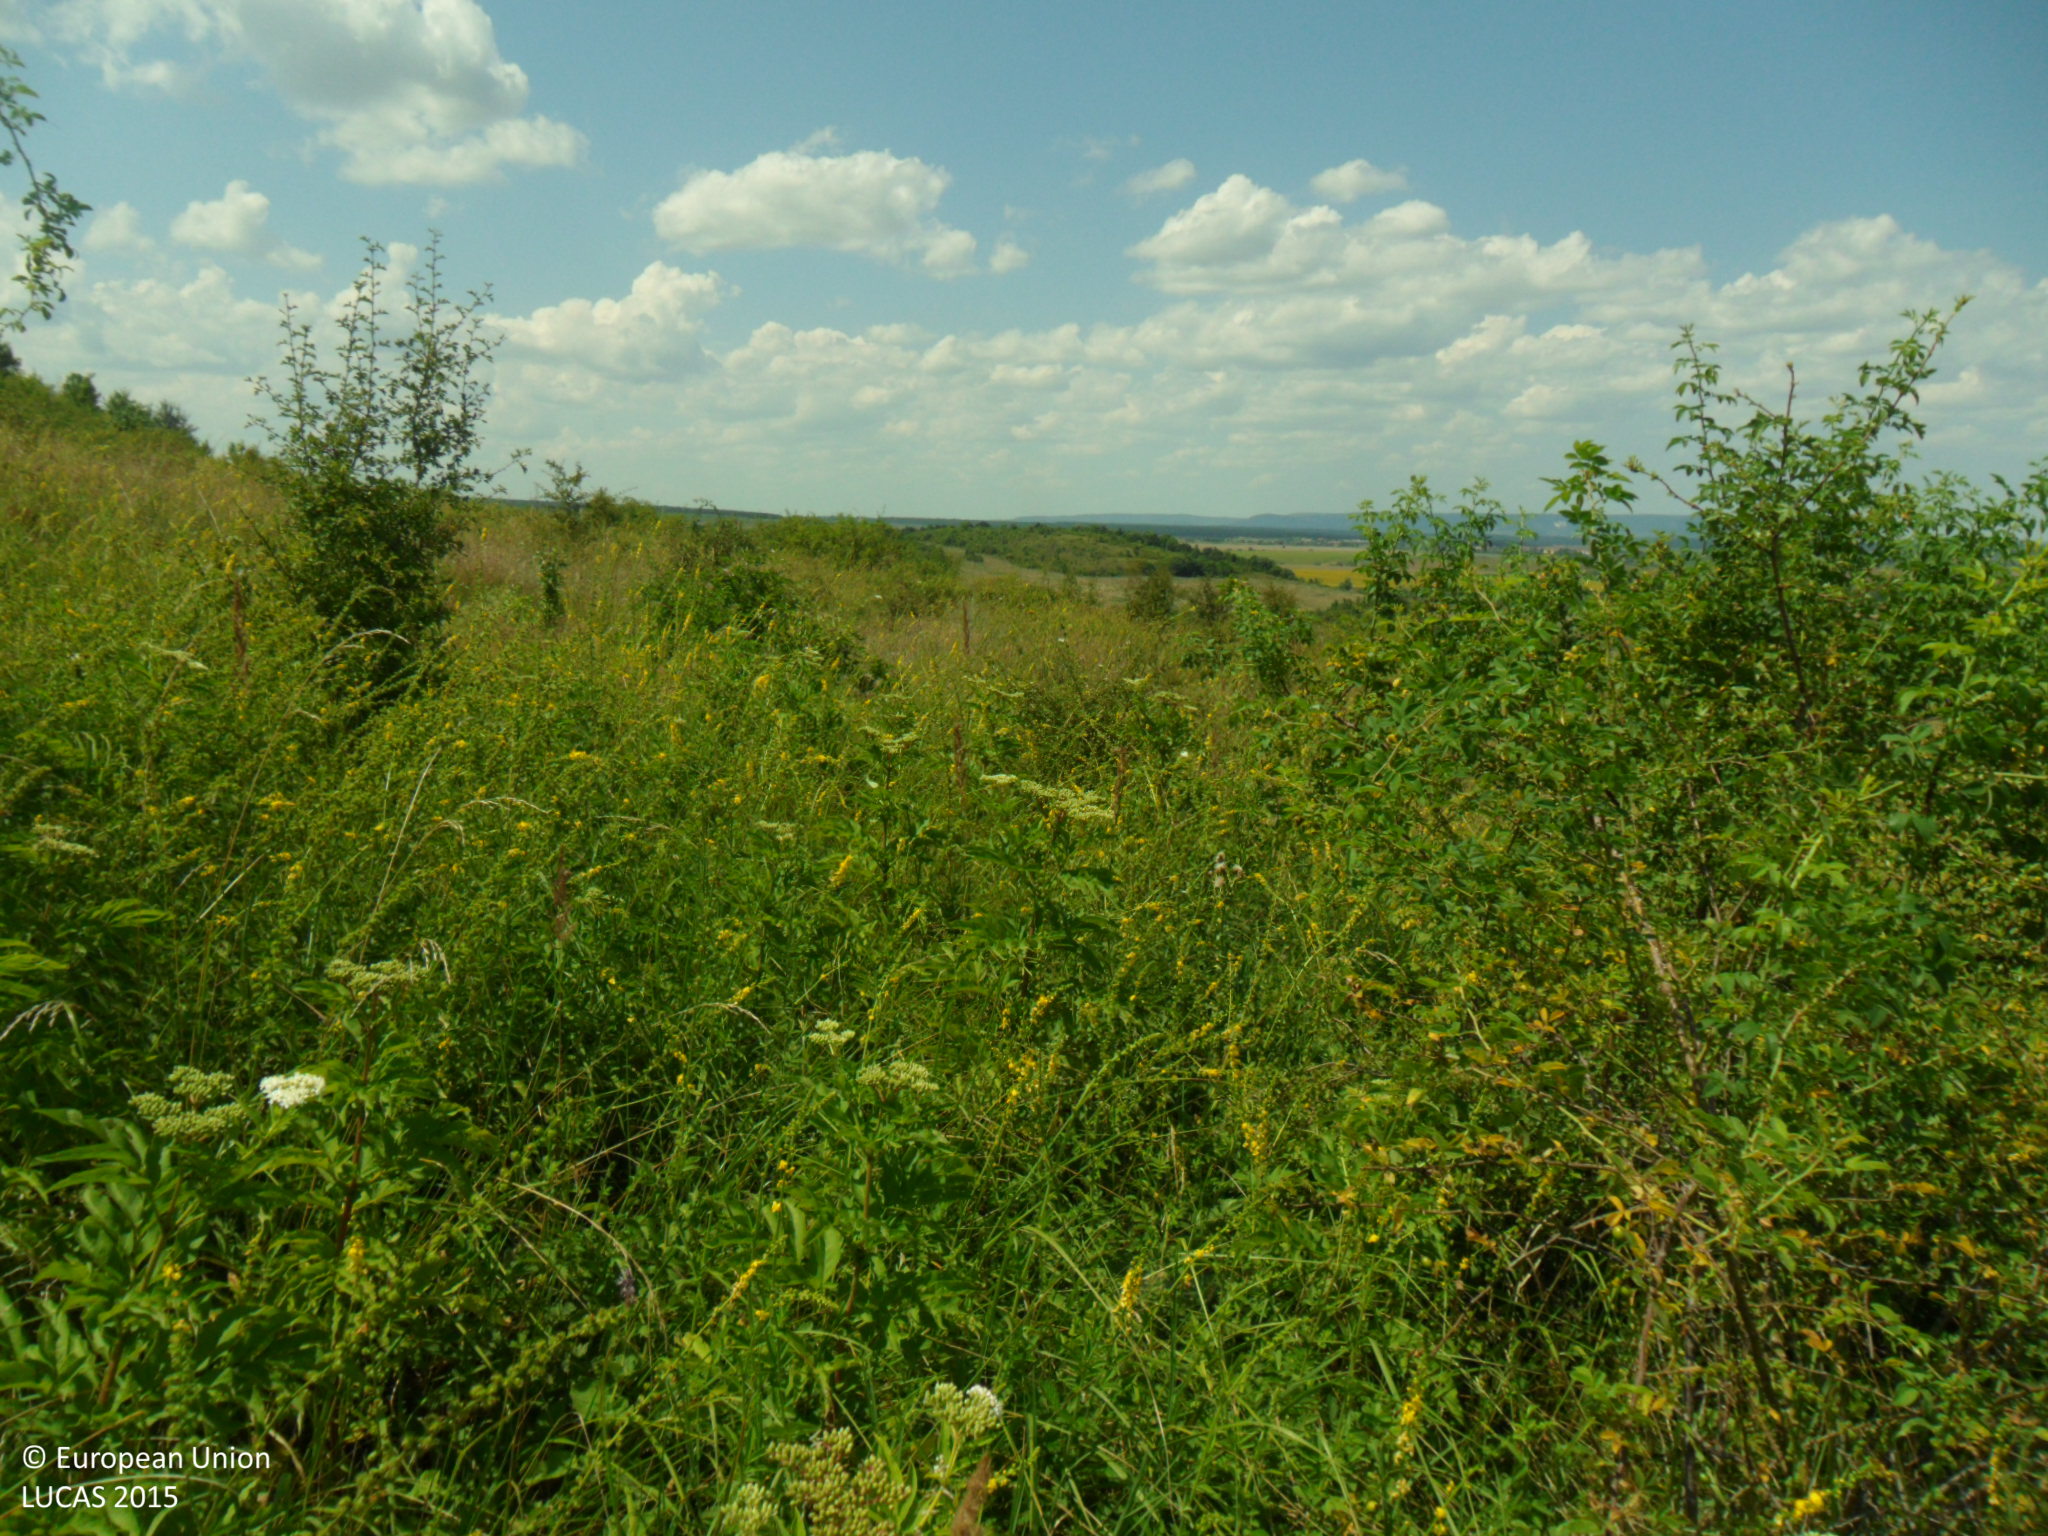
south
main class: Woodland
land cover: Broadleaved woodland
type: mesophytic deciduous forest
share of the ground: > 75 %
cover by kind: broadleaved forest trees 80 %, shrubs 15 %, herbaceous plants 5 %
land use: Forestry
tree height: < 5 m
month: July
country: BG
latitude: 43.0687
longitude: 26.9723
